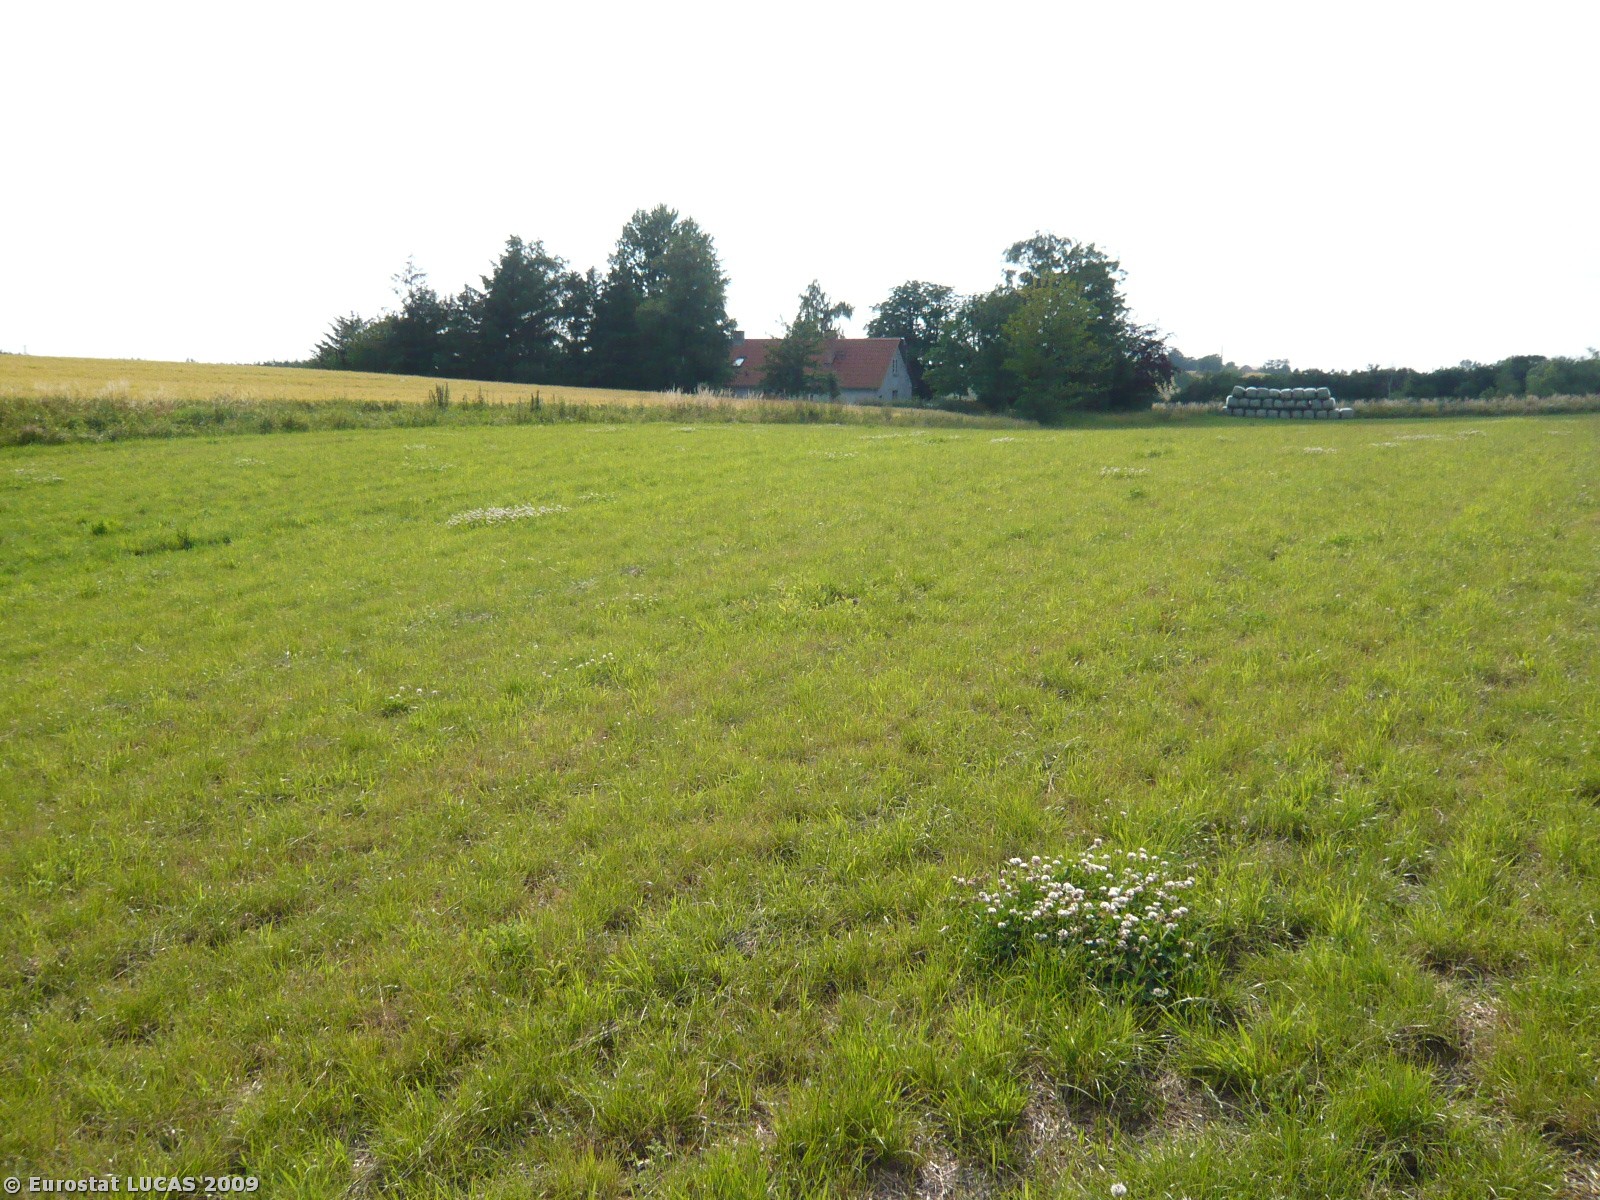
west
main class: Grassland
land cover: Grassland without tree/shrub cover
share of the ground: > 75 %
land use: Agriculture (excluding fallow land and kitchen gardens)
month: July
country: DK
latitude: 55.8540
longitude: 11.6118
